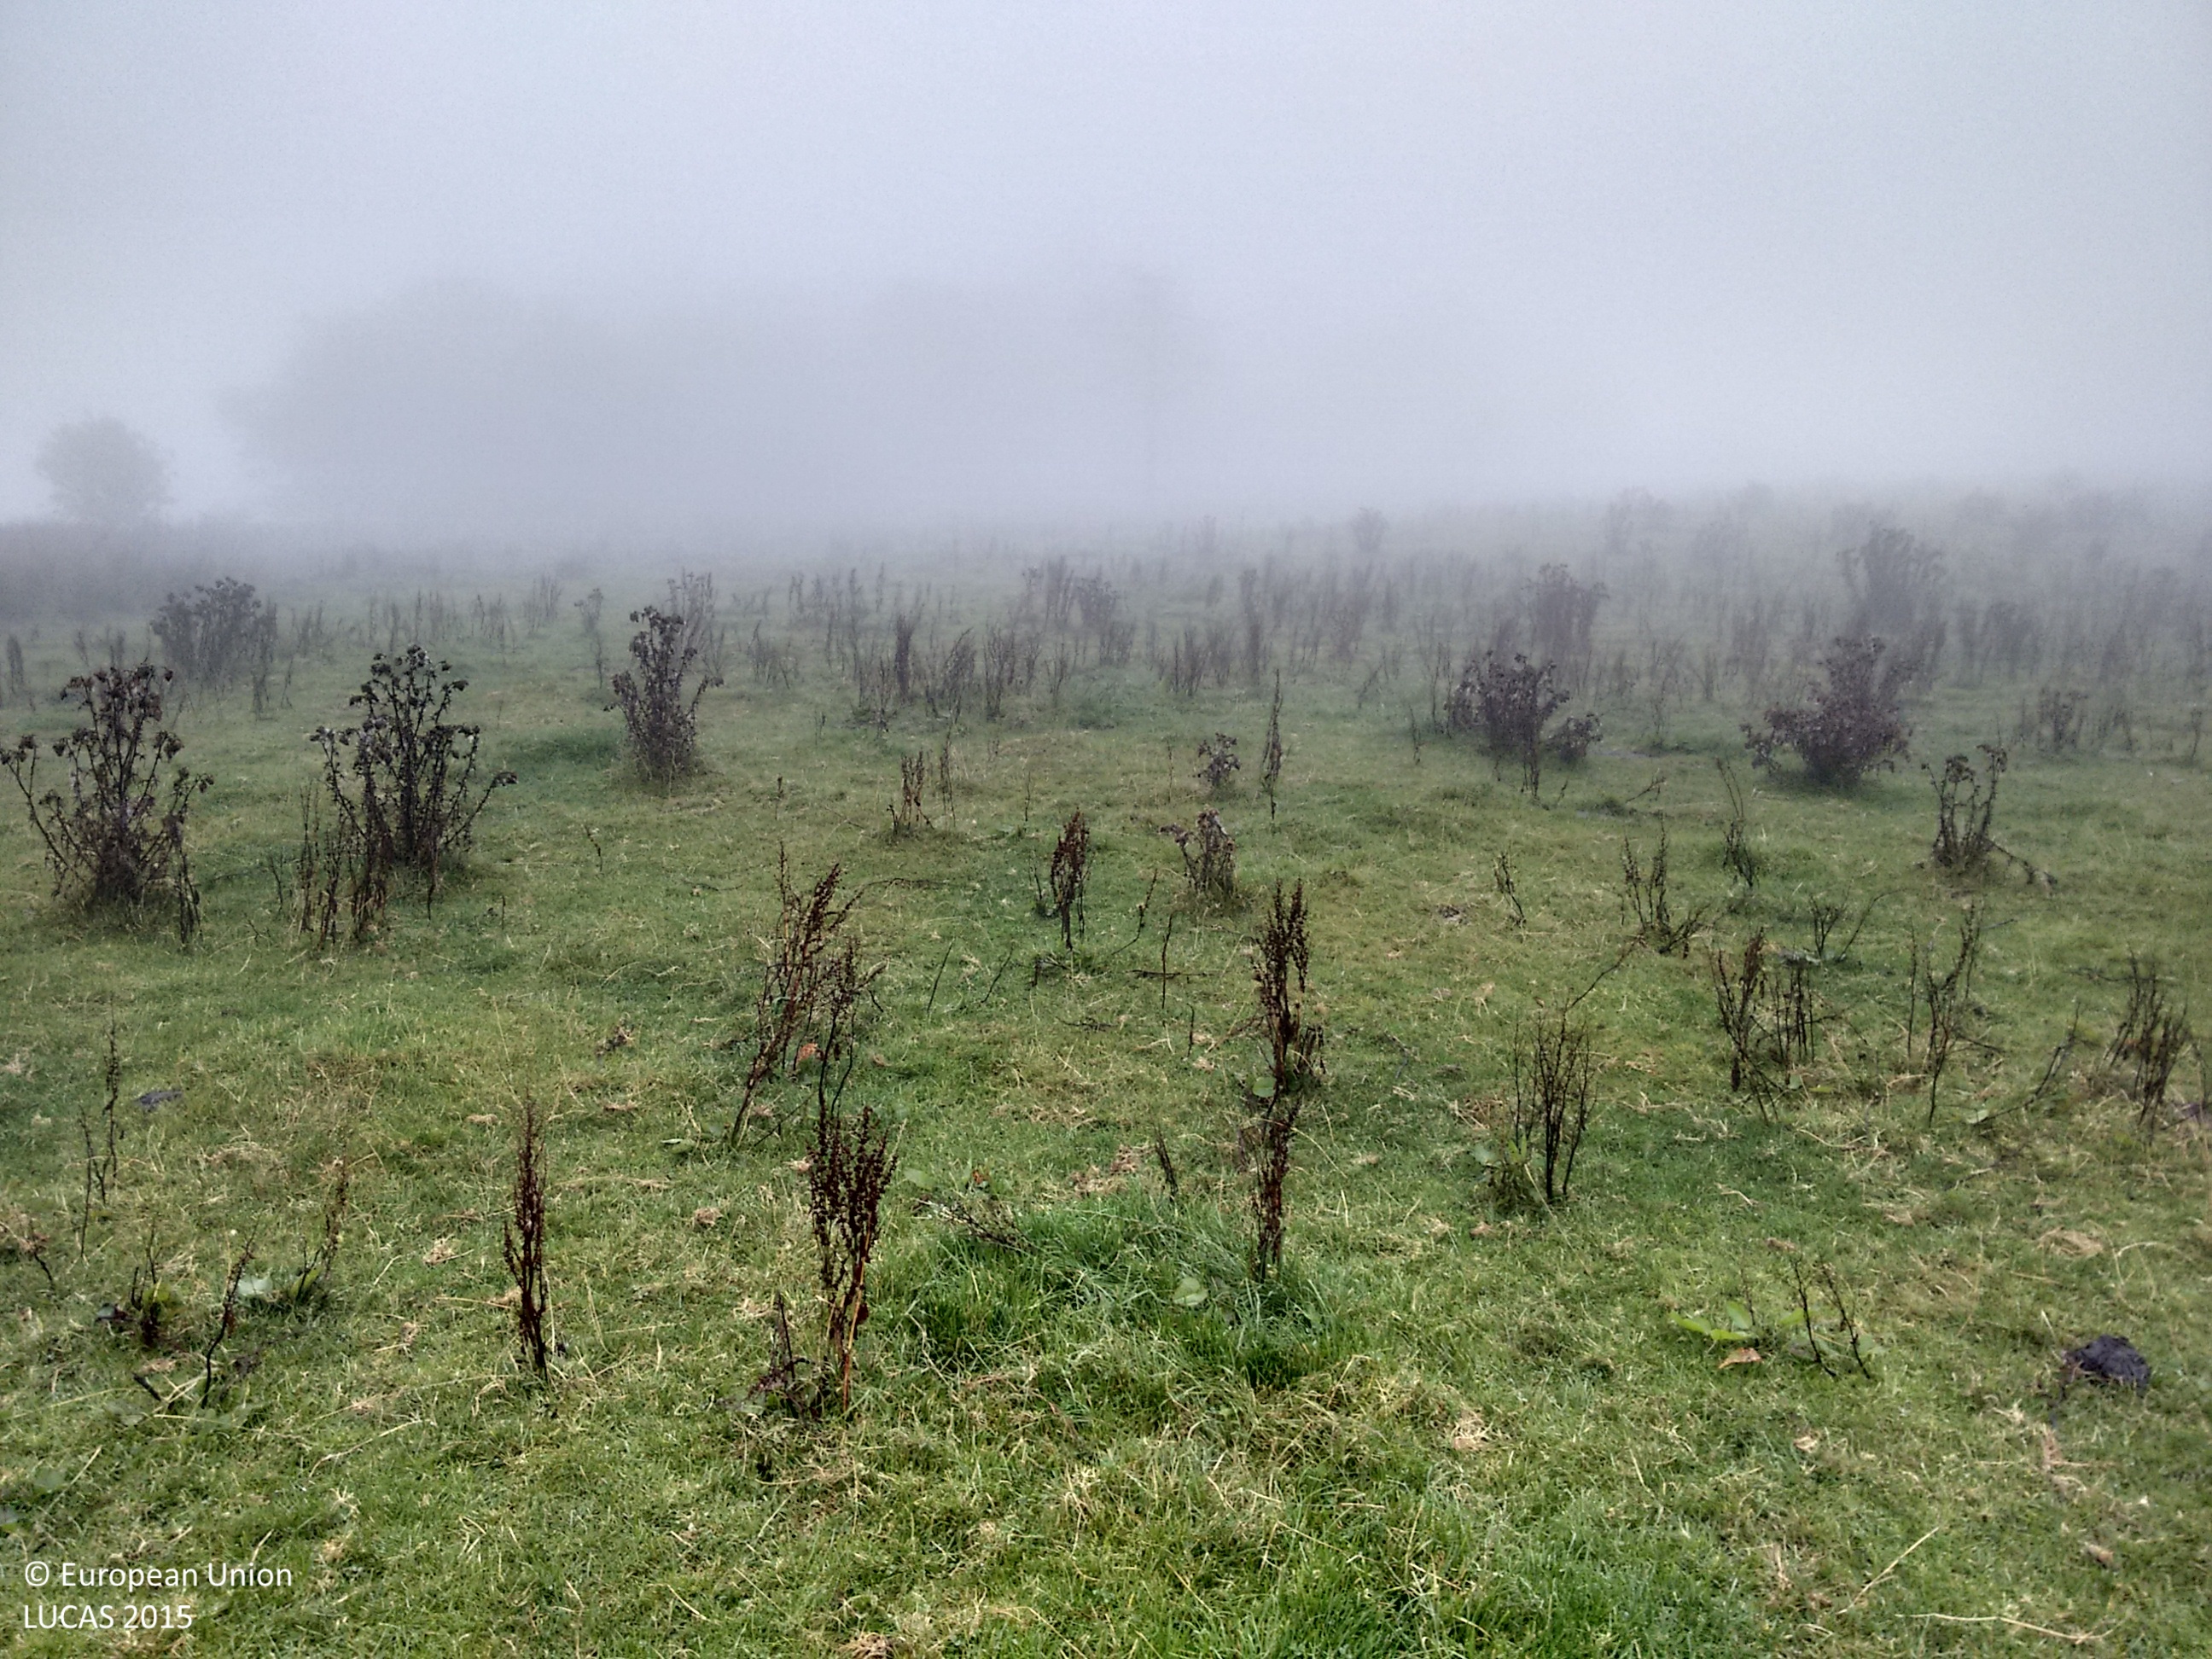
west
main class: Grassland
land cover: Grassland without tree/shrub cover
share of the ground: > 75 %
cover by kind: herbaceous plants 100 %
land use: Agriculture (excluding fallow land and kitchen gardens)
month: September
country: GB
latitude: 52.5778
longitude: -2.9269
